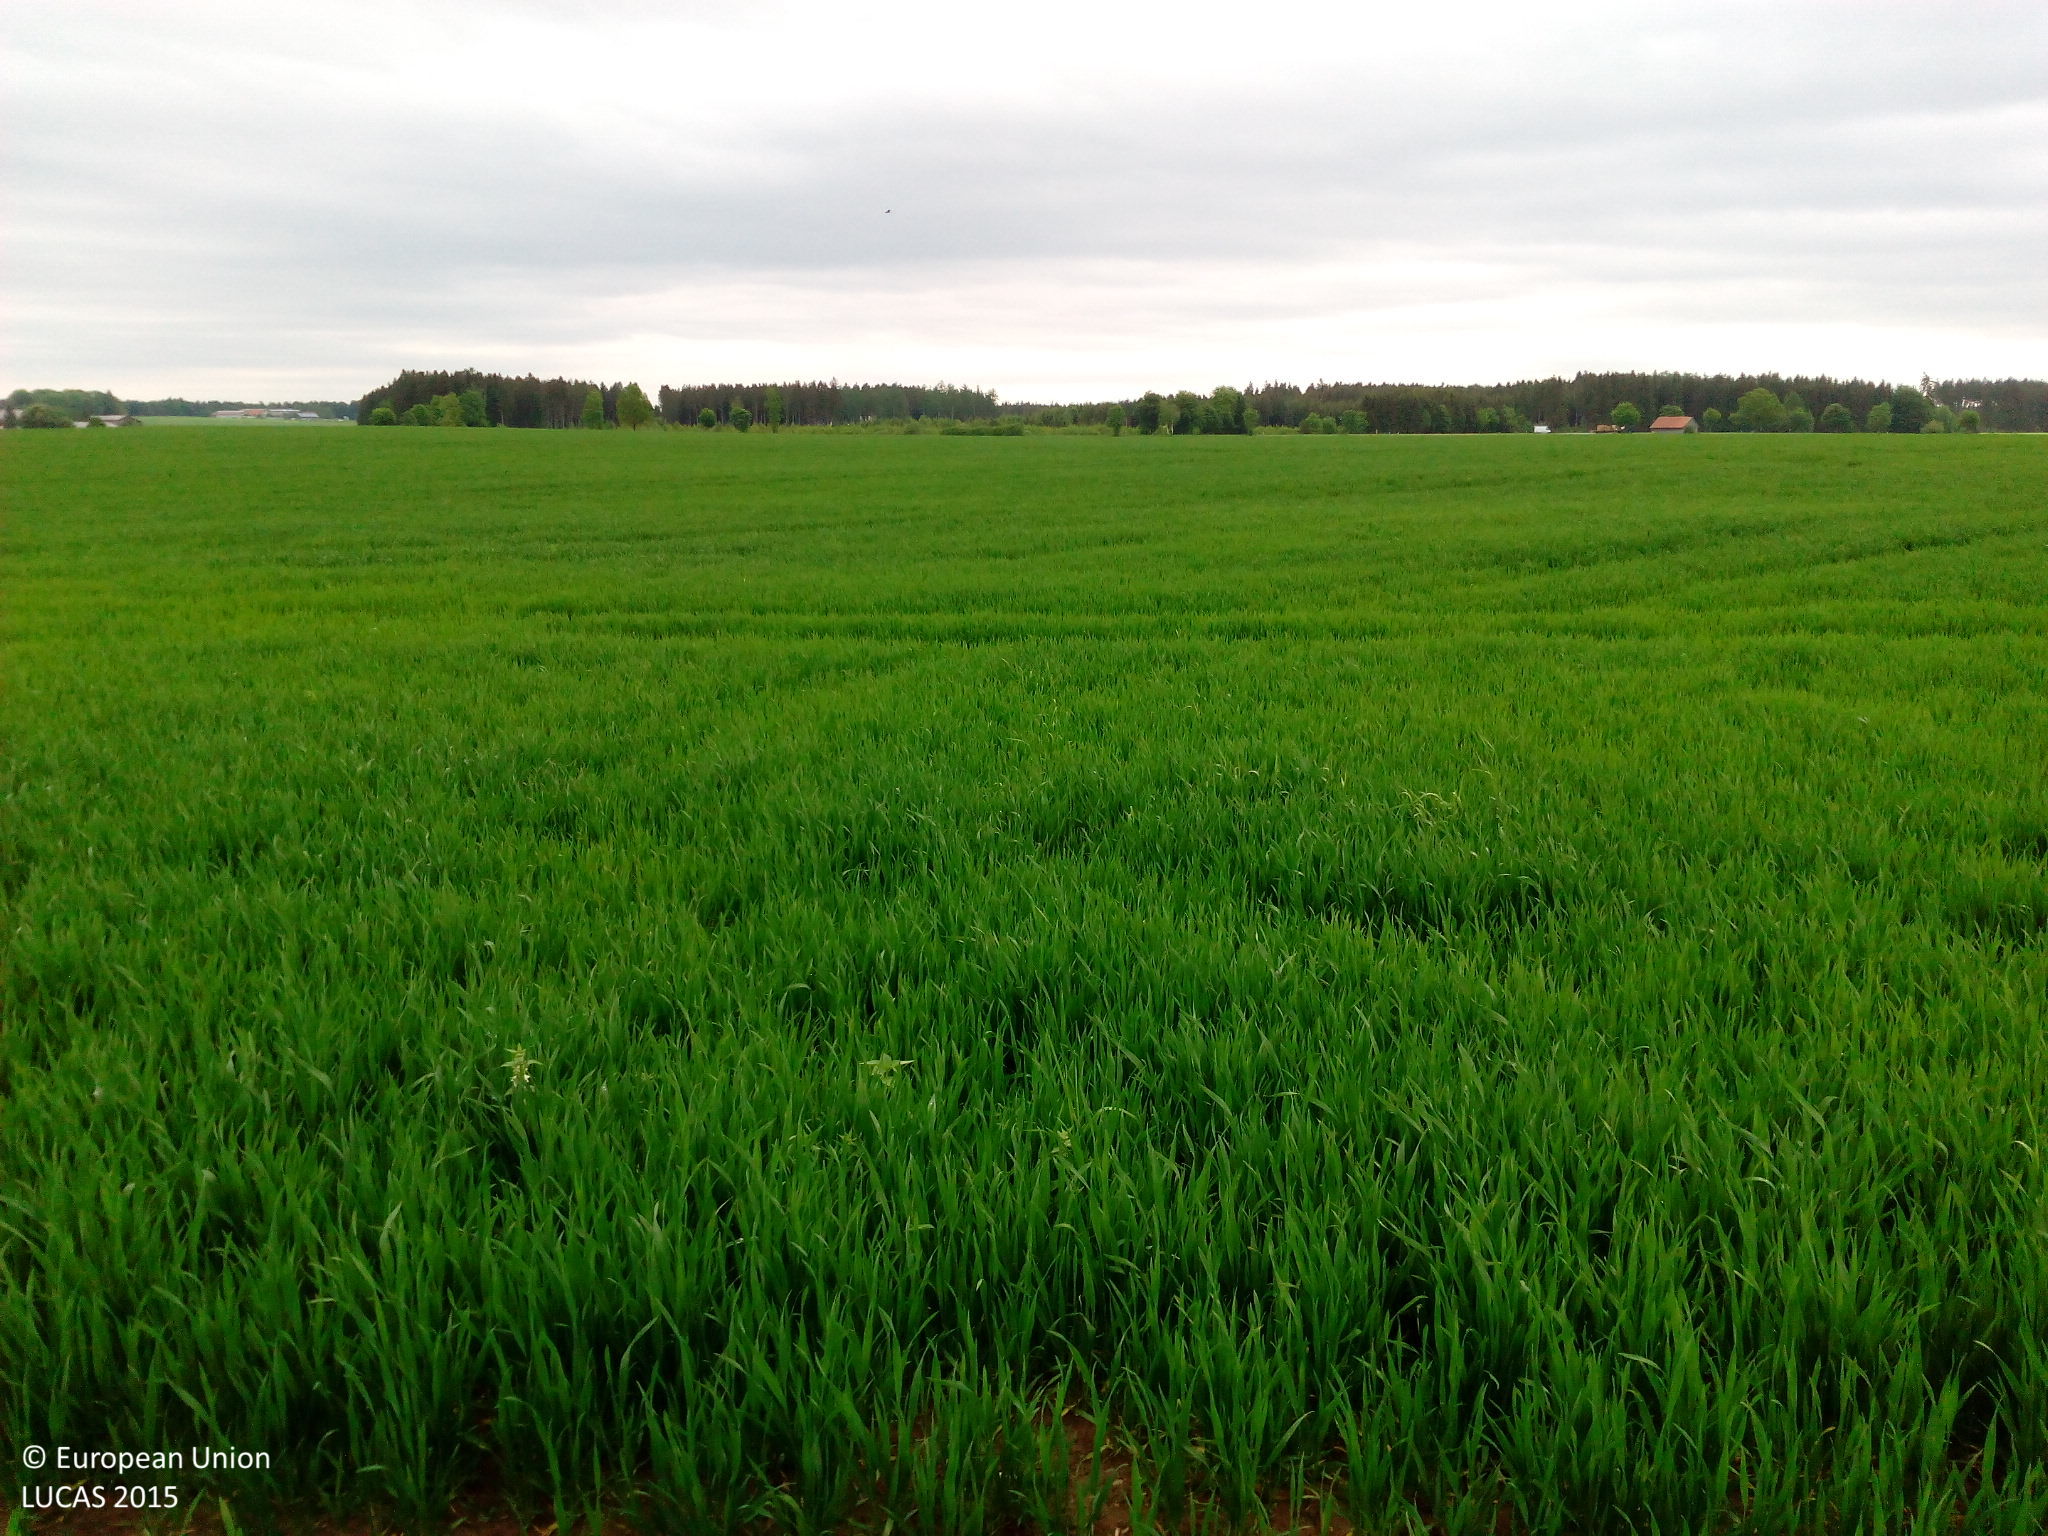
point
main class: Cropland
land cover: Common wheat
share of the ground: > 75 %
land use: Agriculture (excluding fallow land and kitchen gardens)
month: May
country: DE
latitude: 47.9536
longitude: 9.9331
